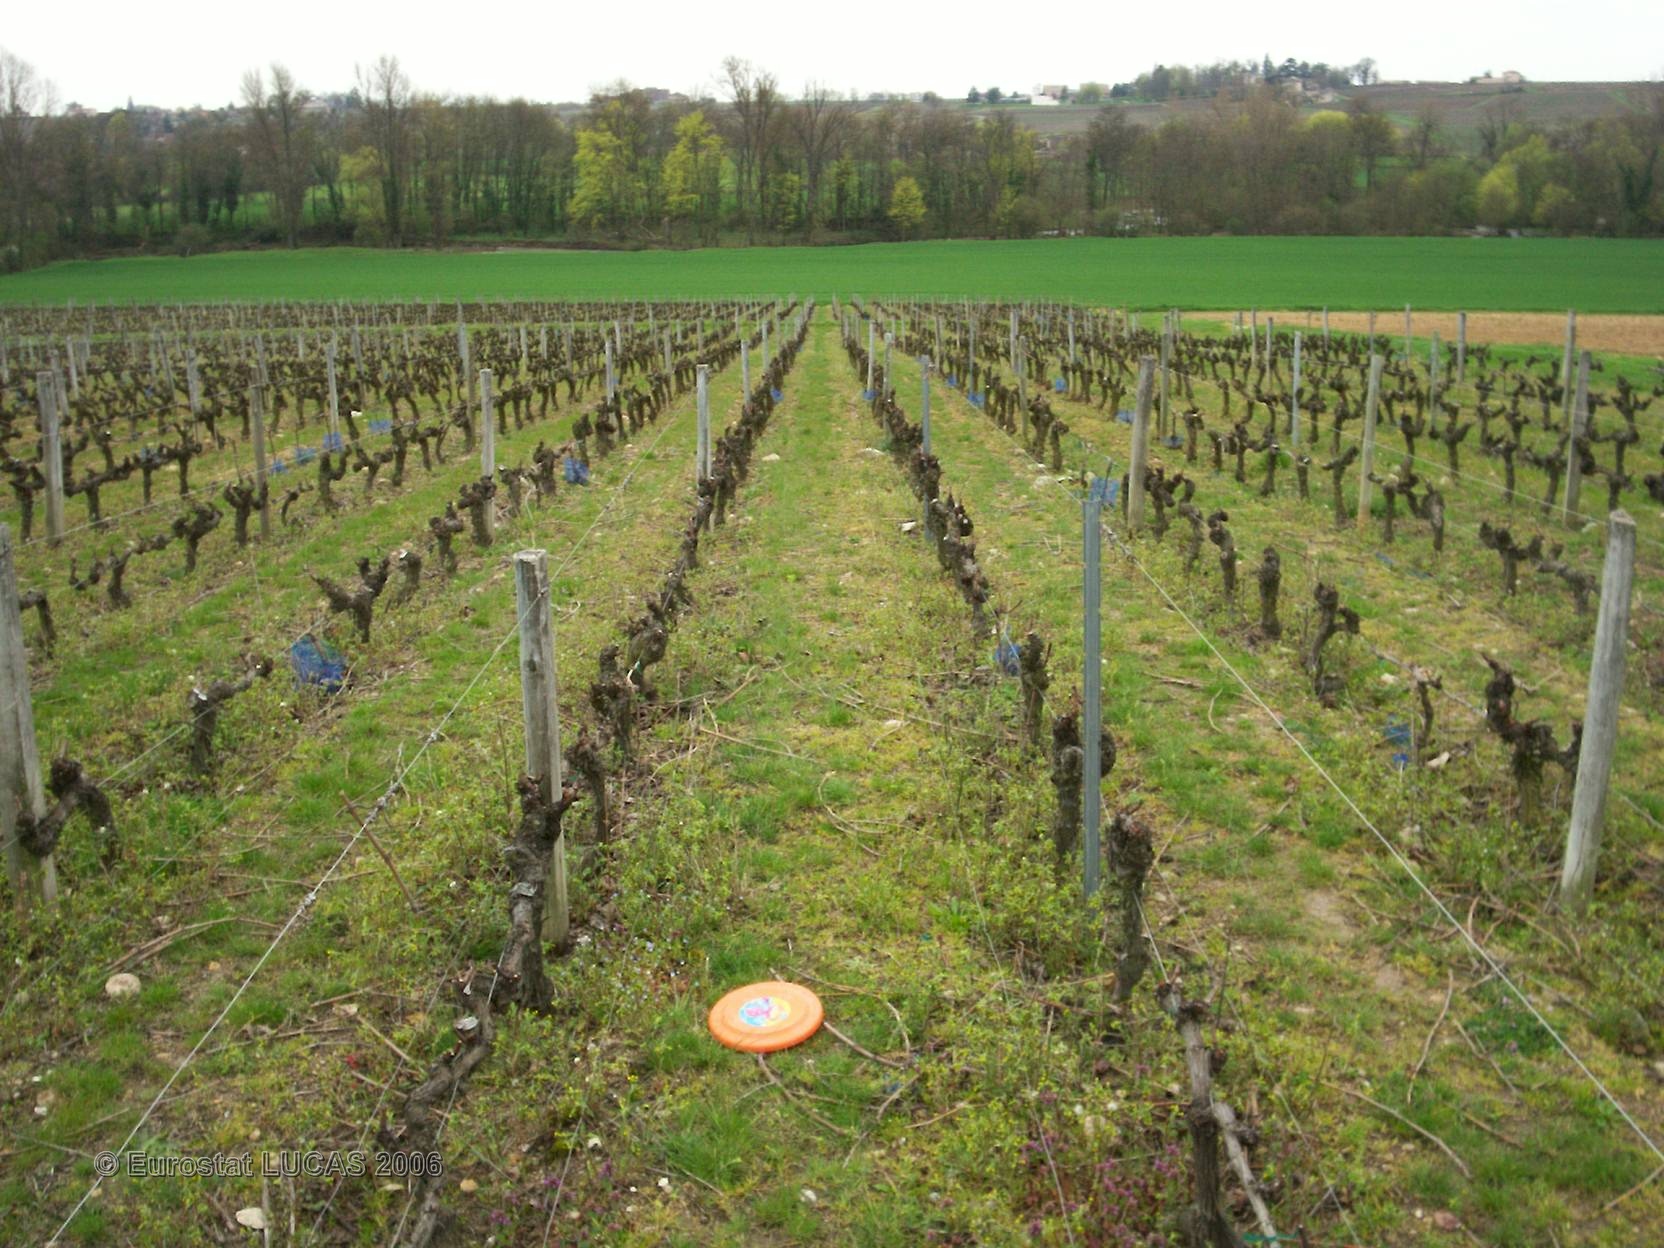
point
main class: Cropland
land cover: Vineyards
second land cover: Grassland without tree/shrub cover
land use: Agriculture (excluding fallow land and kitchen gardens)
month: April
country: FR
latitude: 46.1300
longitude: 4.7089
